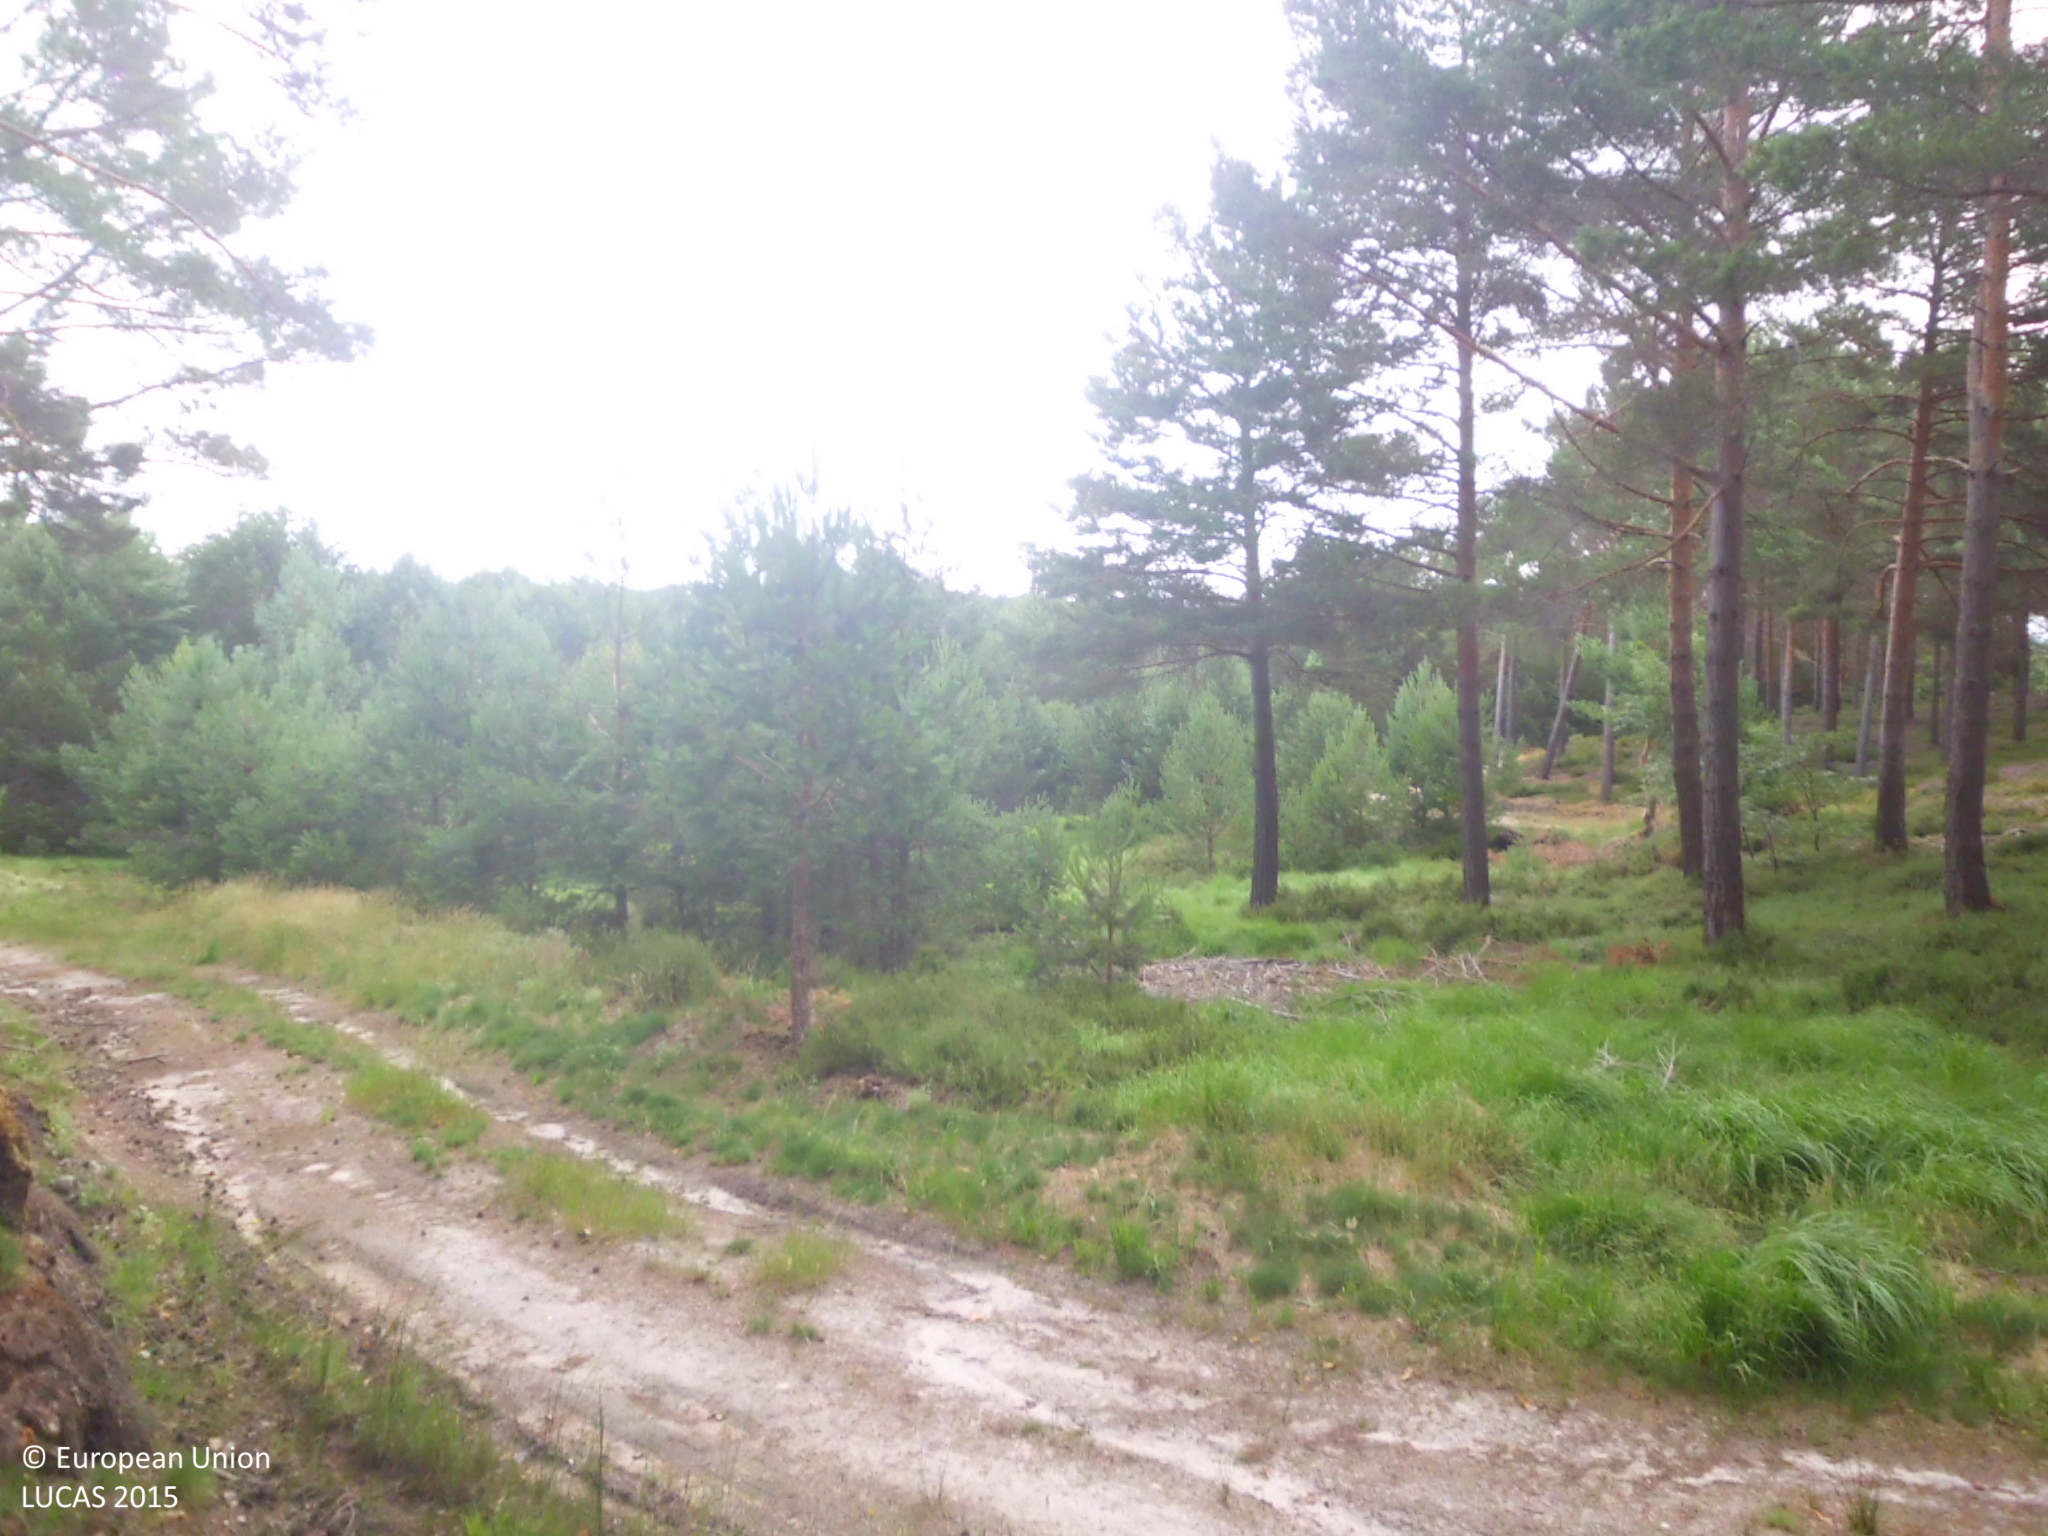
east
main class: Woodland
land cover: Pine dominated coniferous woodland
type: coniferous forest of the mediterranean region
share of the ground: > 75 %
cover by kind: coniferous forest trees 80 %, consolidated bare surface 15 %, shrubs 5 %
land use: Forestry
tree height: > 5 m
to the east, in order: Pine dominated coniferous woodland; Tracks; Pine dominated coniferous woodland; Tracks; Pine dominated coniferous woodland; Tracks; Pine dominated coniferous woodland
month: July
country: ES
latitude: 42.6835
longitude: -3.9940
